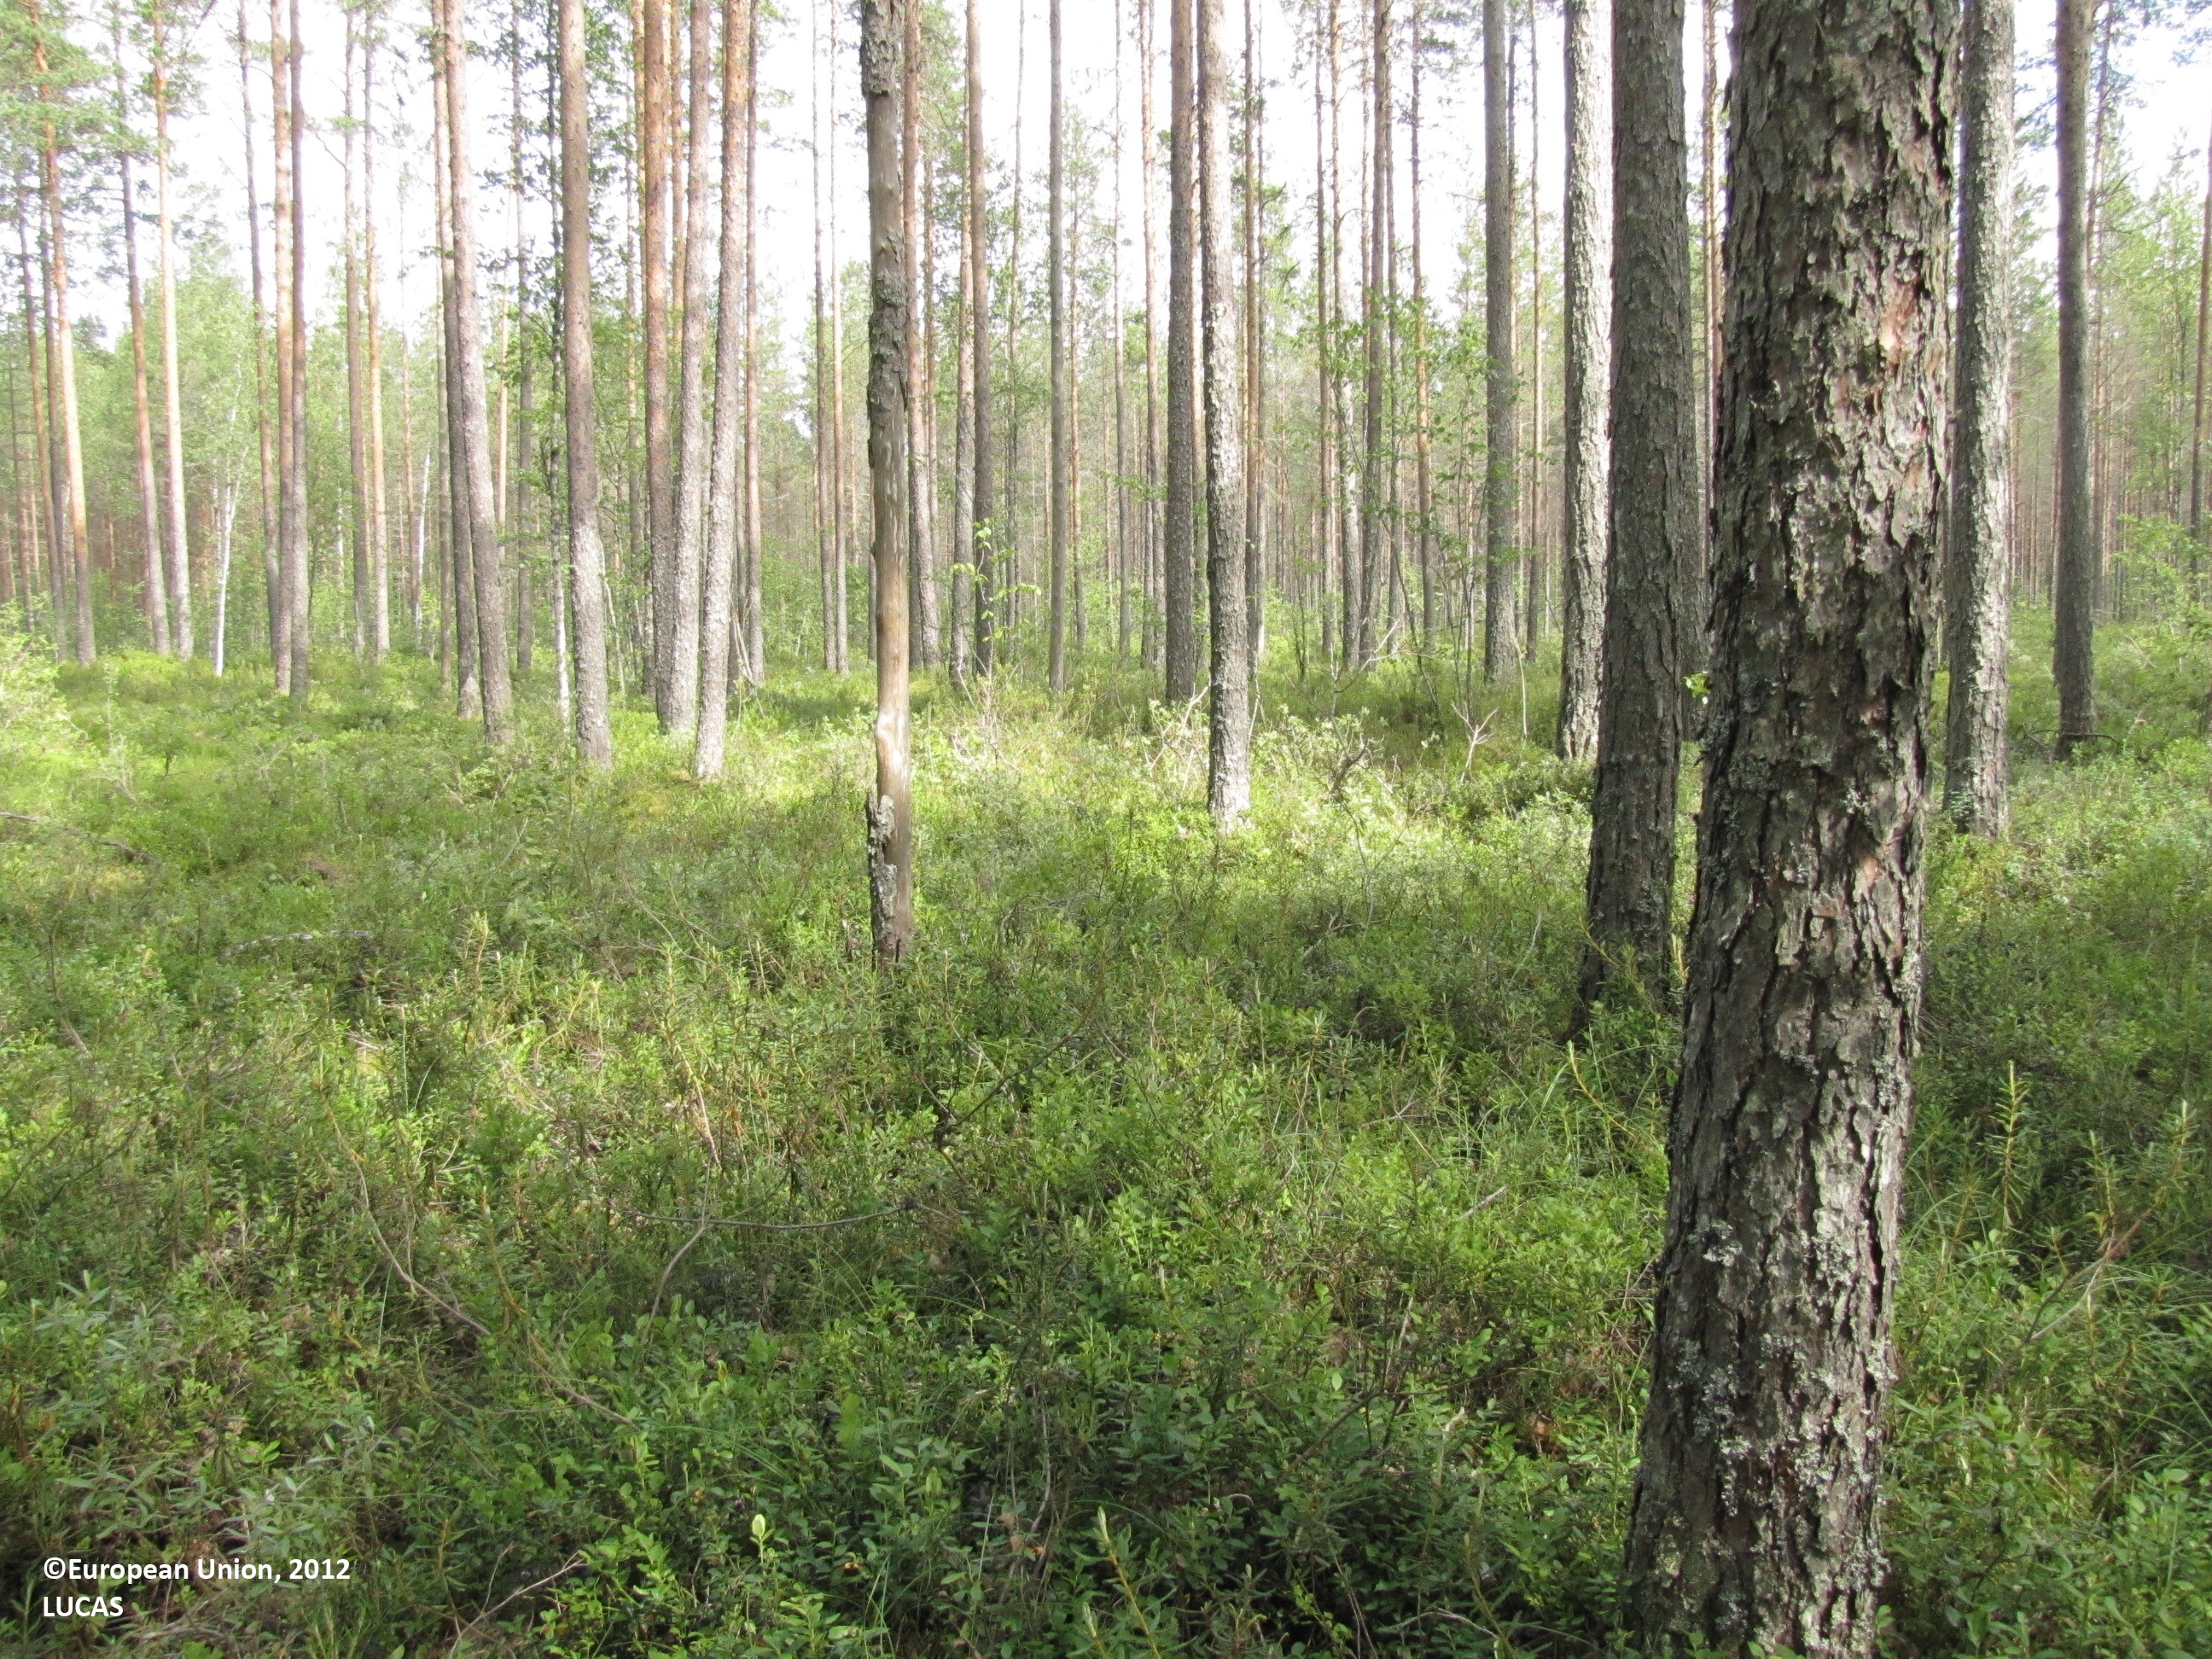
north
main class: Woodland
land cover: Pine dominated coniferous woodland
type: mire and swamp forests
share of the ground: > 75 %
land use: Forestry
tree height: > 5 m
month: July
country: FI
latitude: 62.4087
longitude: 23.2474
